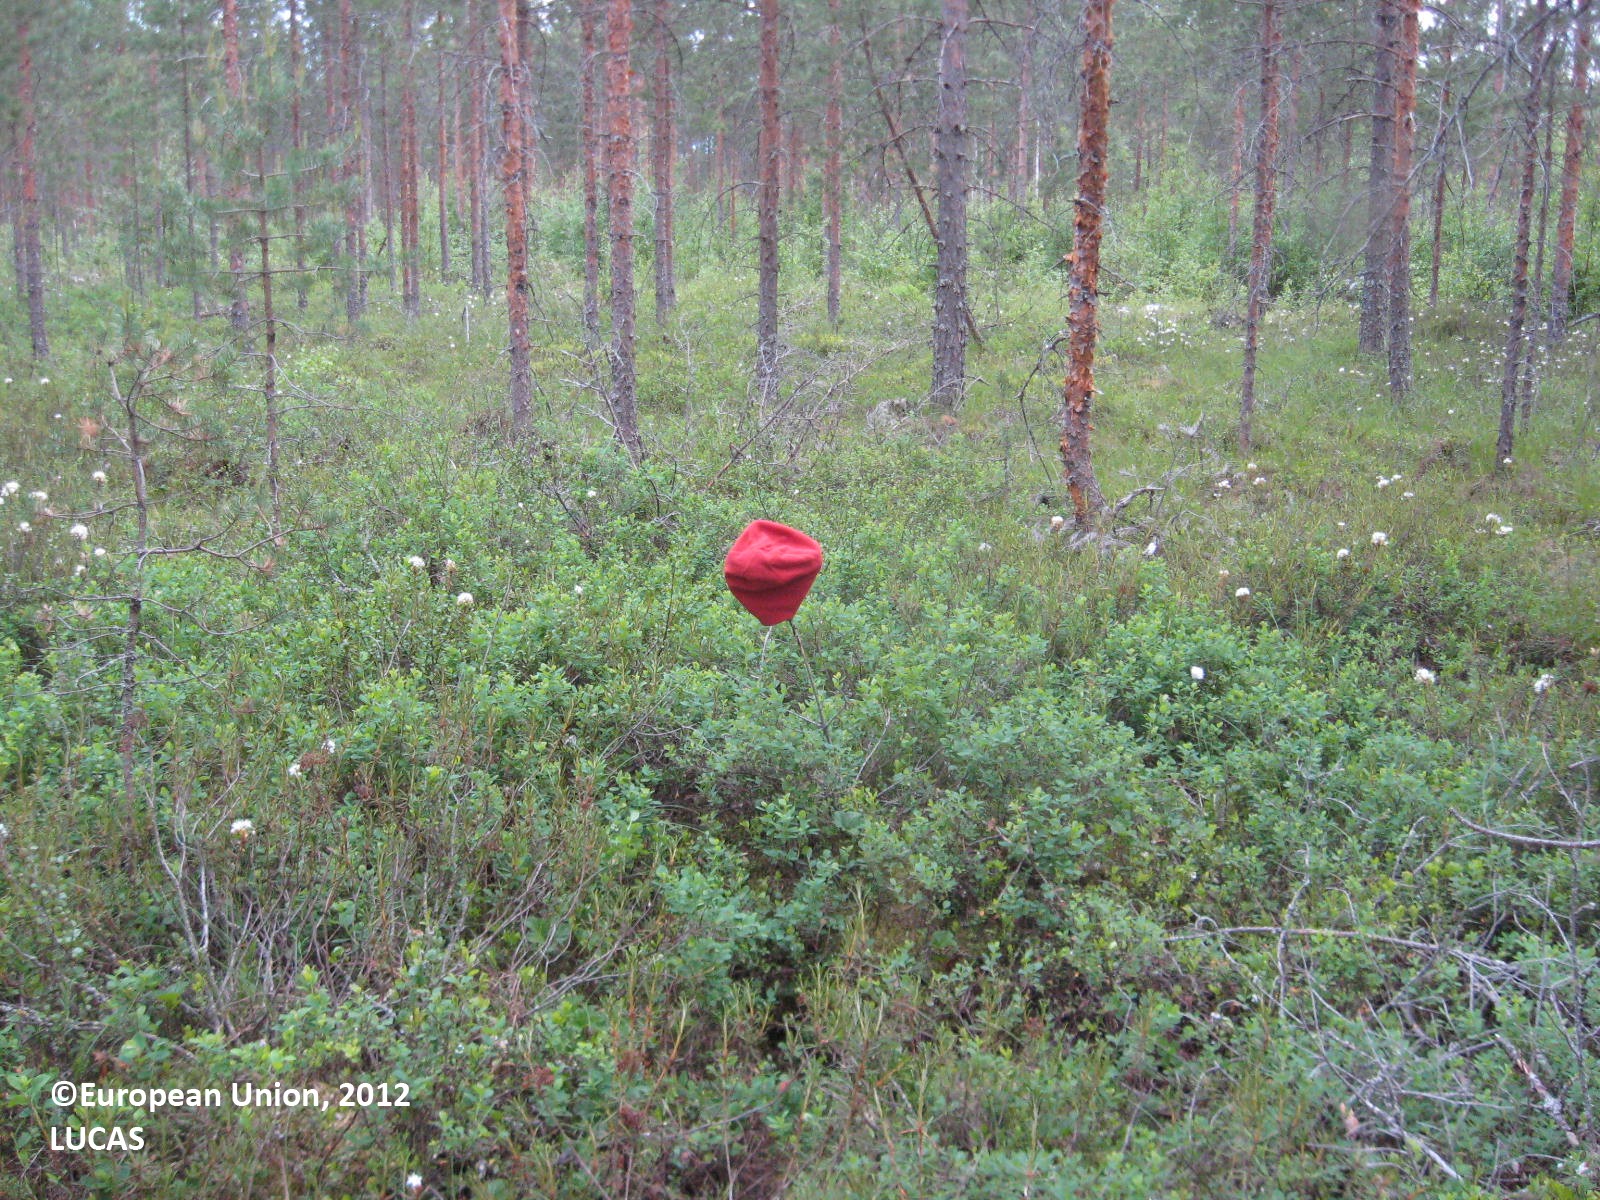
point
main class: Woodland
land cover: Pine dominated coniferous woodland
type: boreal forest
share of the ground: > 75 %
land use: Forestry
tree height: > 5 m
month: June
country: FI
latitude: 63.0081
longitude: 22.6736
